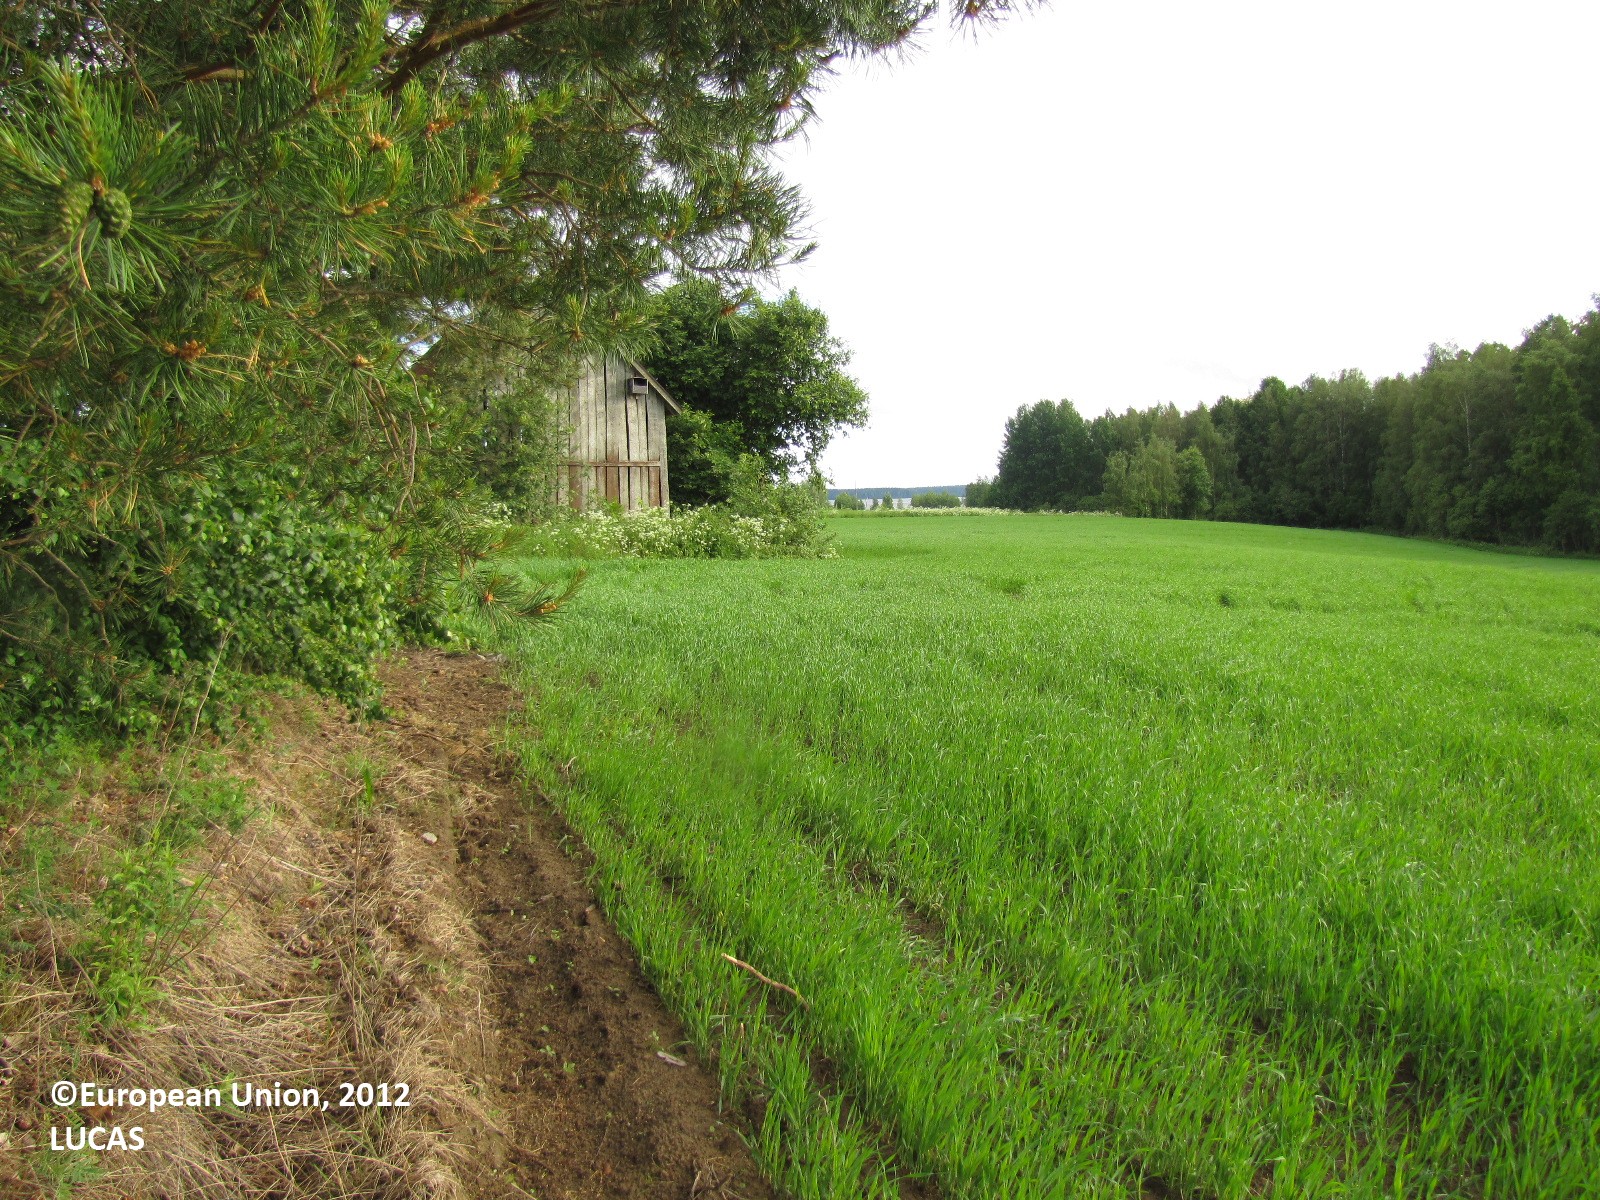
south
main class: Cropland
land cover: Barley
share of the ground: 50 - 75 %
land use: Agriculture (excluding fallow land and kitchen gardens)
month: June
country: FI
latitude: 61.2356
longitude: 24.5770
